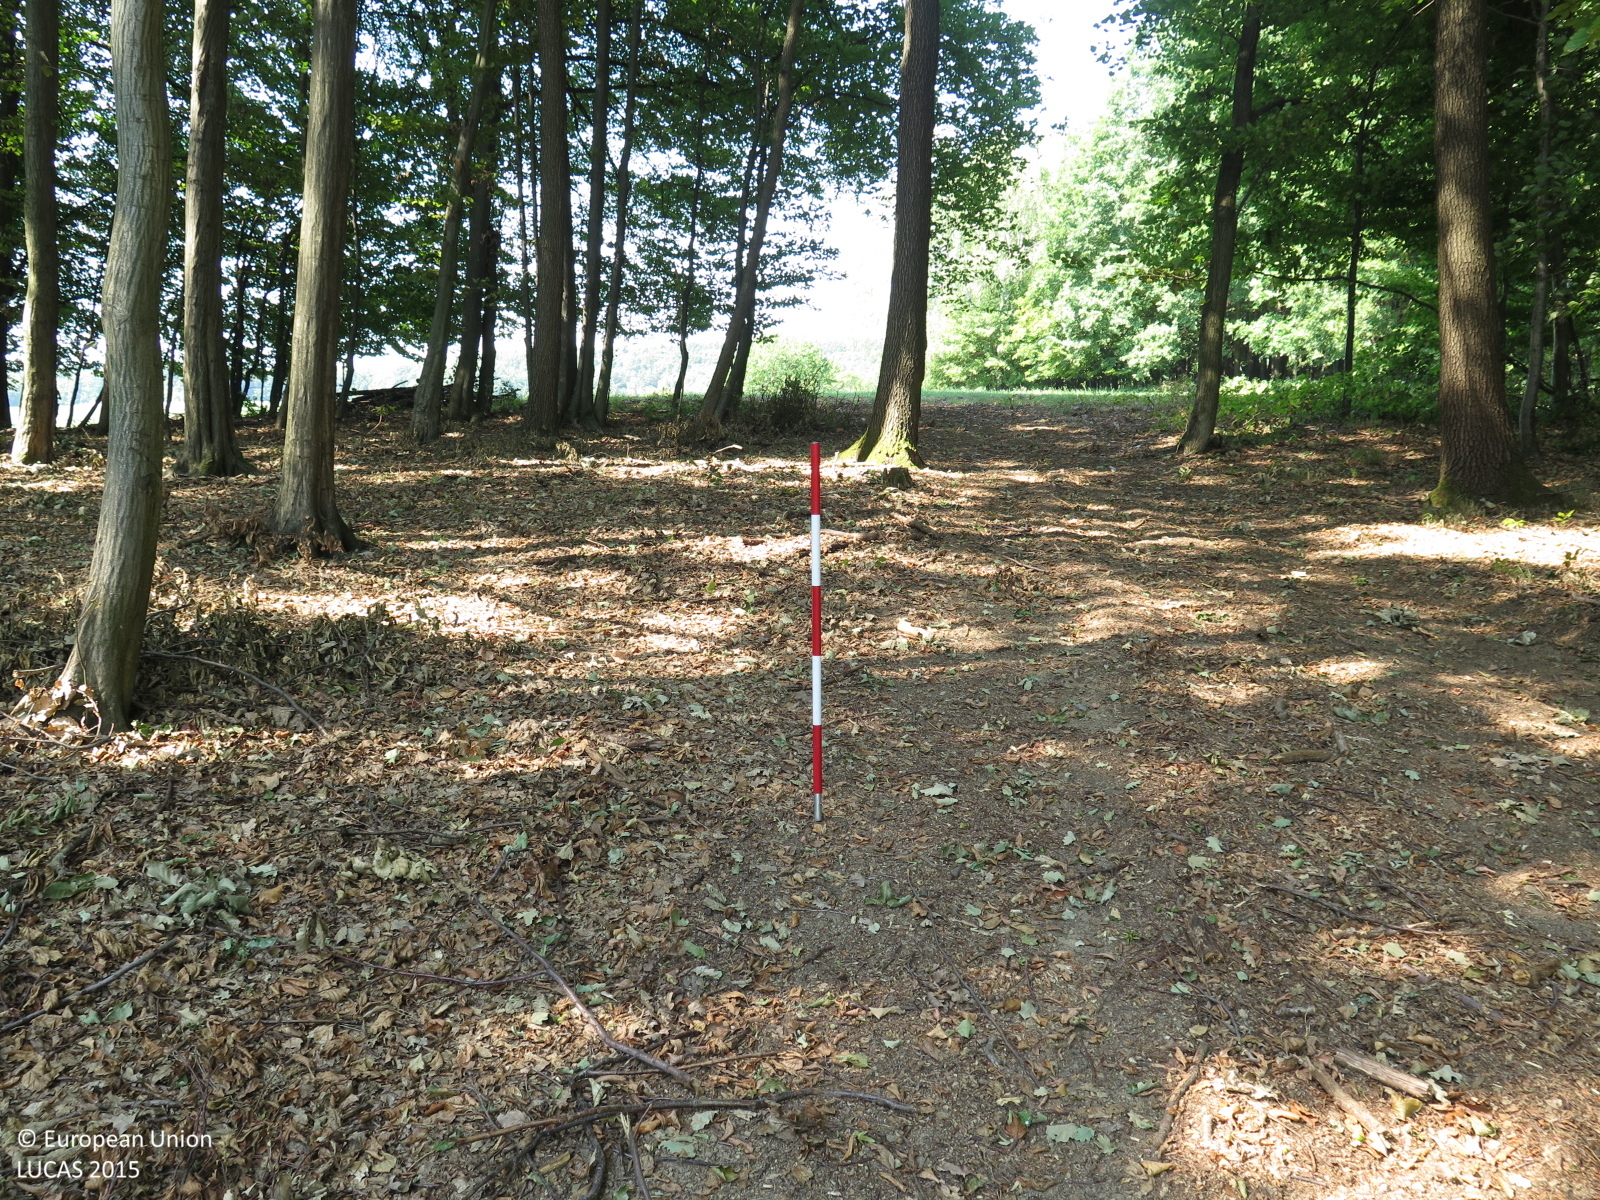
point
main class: Woodland
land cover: Broadleaved woodland
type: mesophytic deciduous forest
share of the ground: > 75 %
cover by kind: broadleaved forest trees 95 %, herbaceous plants 5 %
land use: Forestry
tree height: > 5 m
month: September
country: CZ
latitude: 49.1860
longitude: 17.6547
